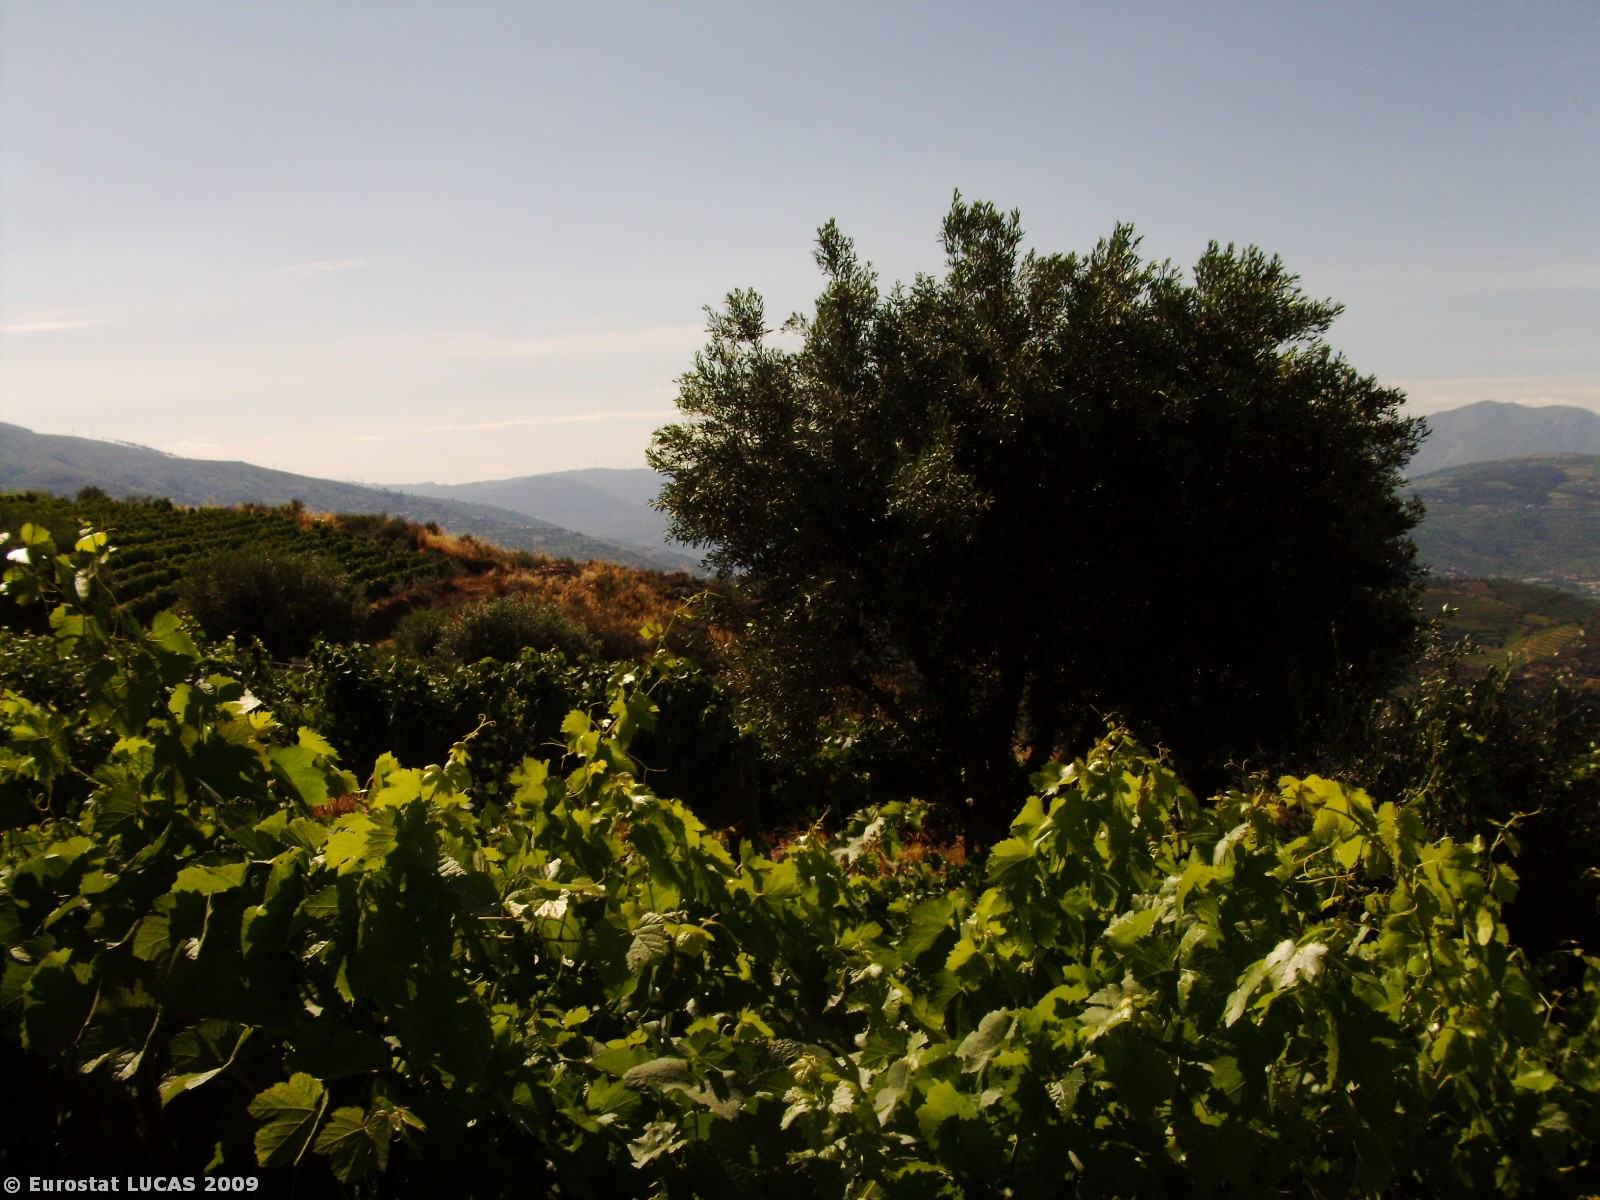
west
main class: Cropland
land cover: Vineyards
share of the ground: 25 - 50 %
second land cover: Bare land
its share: > 75 %
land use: Agriculture (excluding fallow land and kitchen gardens)
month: July
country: PT
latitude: 41.1234
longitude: -7.7681
